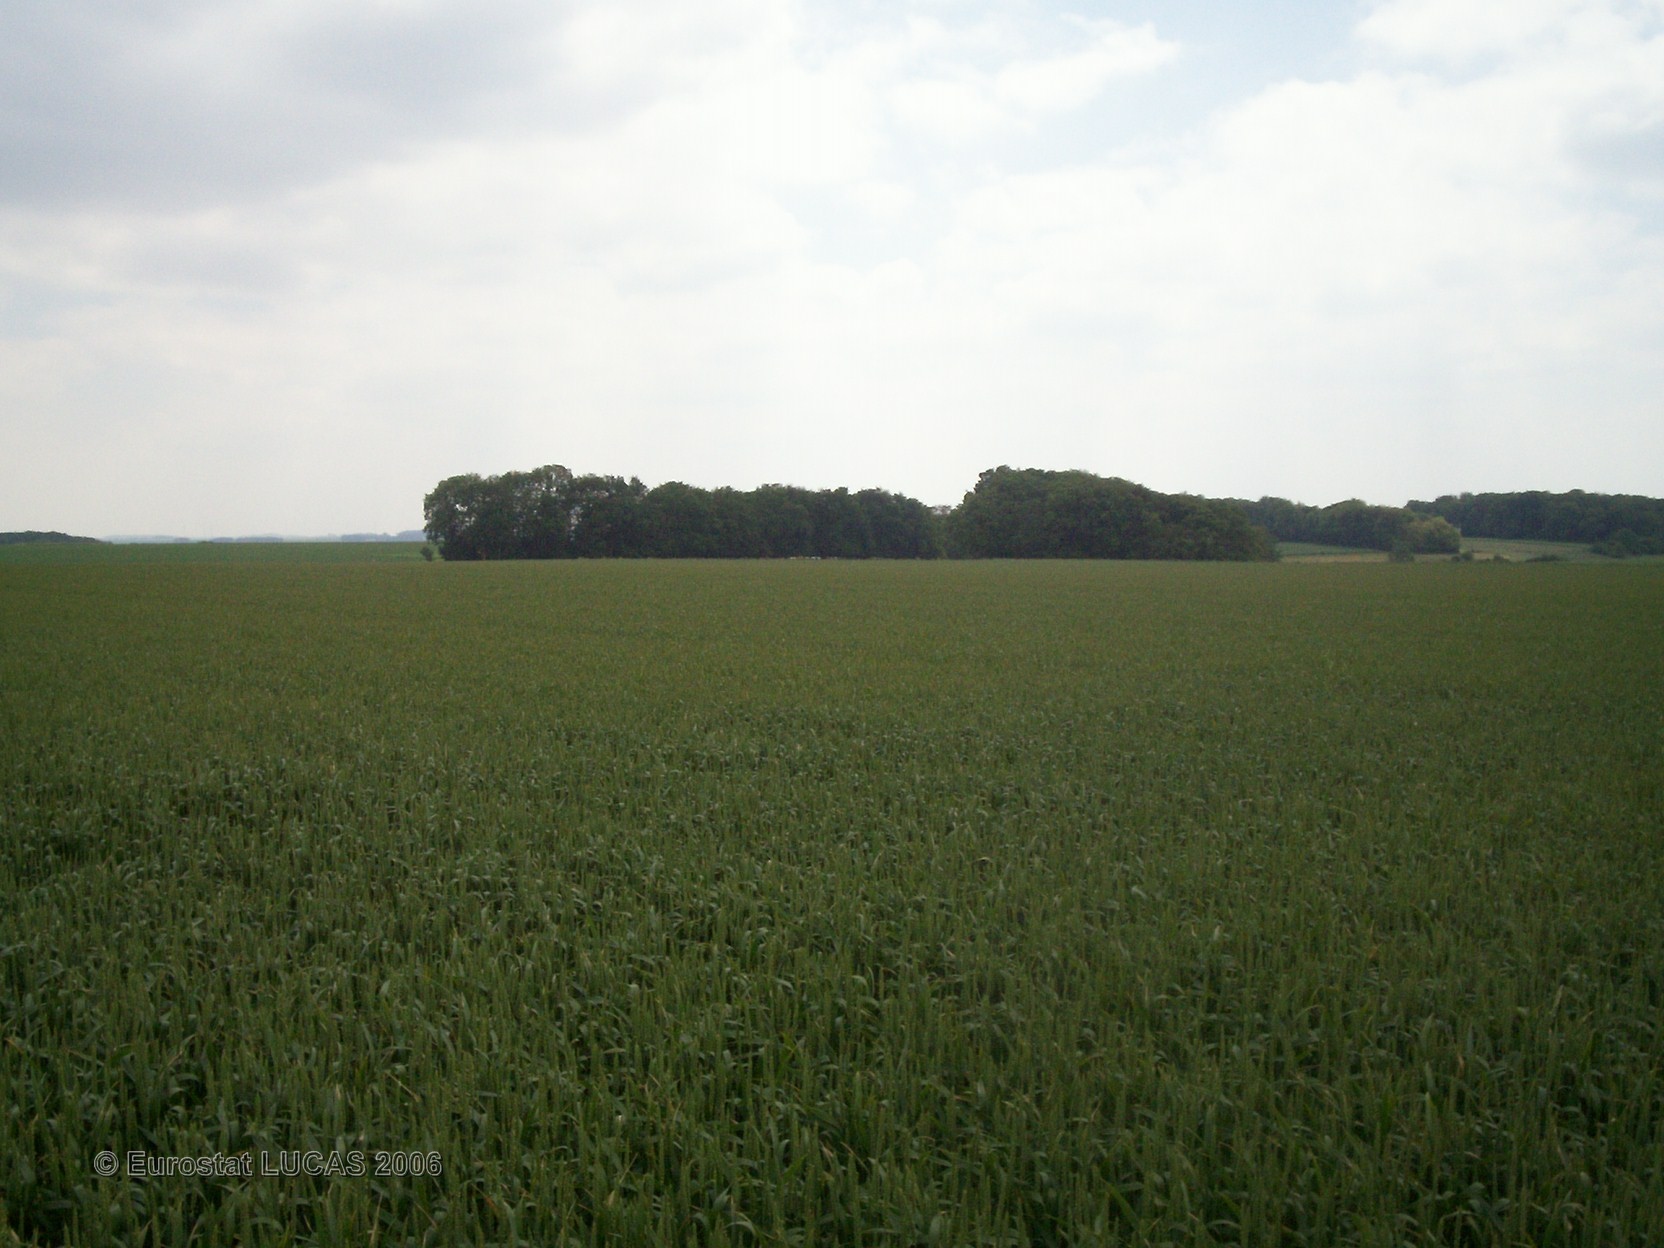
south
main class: Cropland
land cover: Common wheat
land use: Agriculture (excluding fallow land and kitchen gardens)
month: June
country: FR
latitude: 49.9268
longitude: 2.6194
